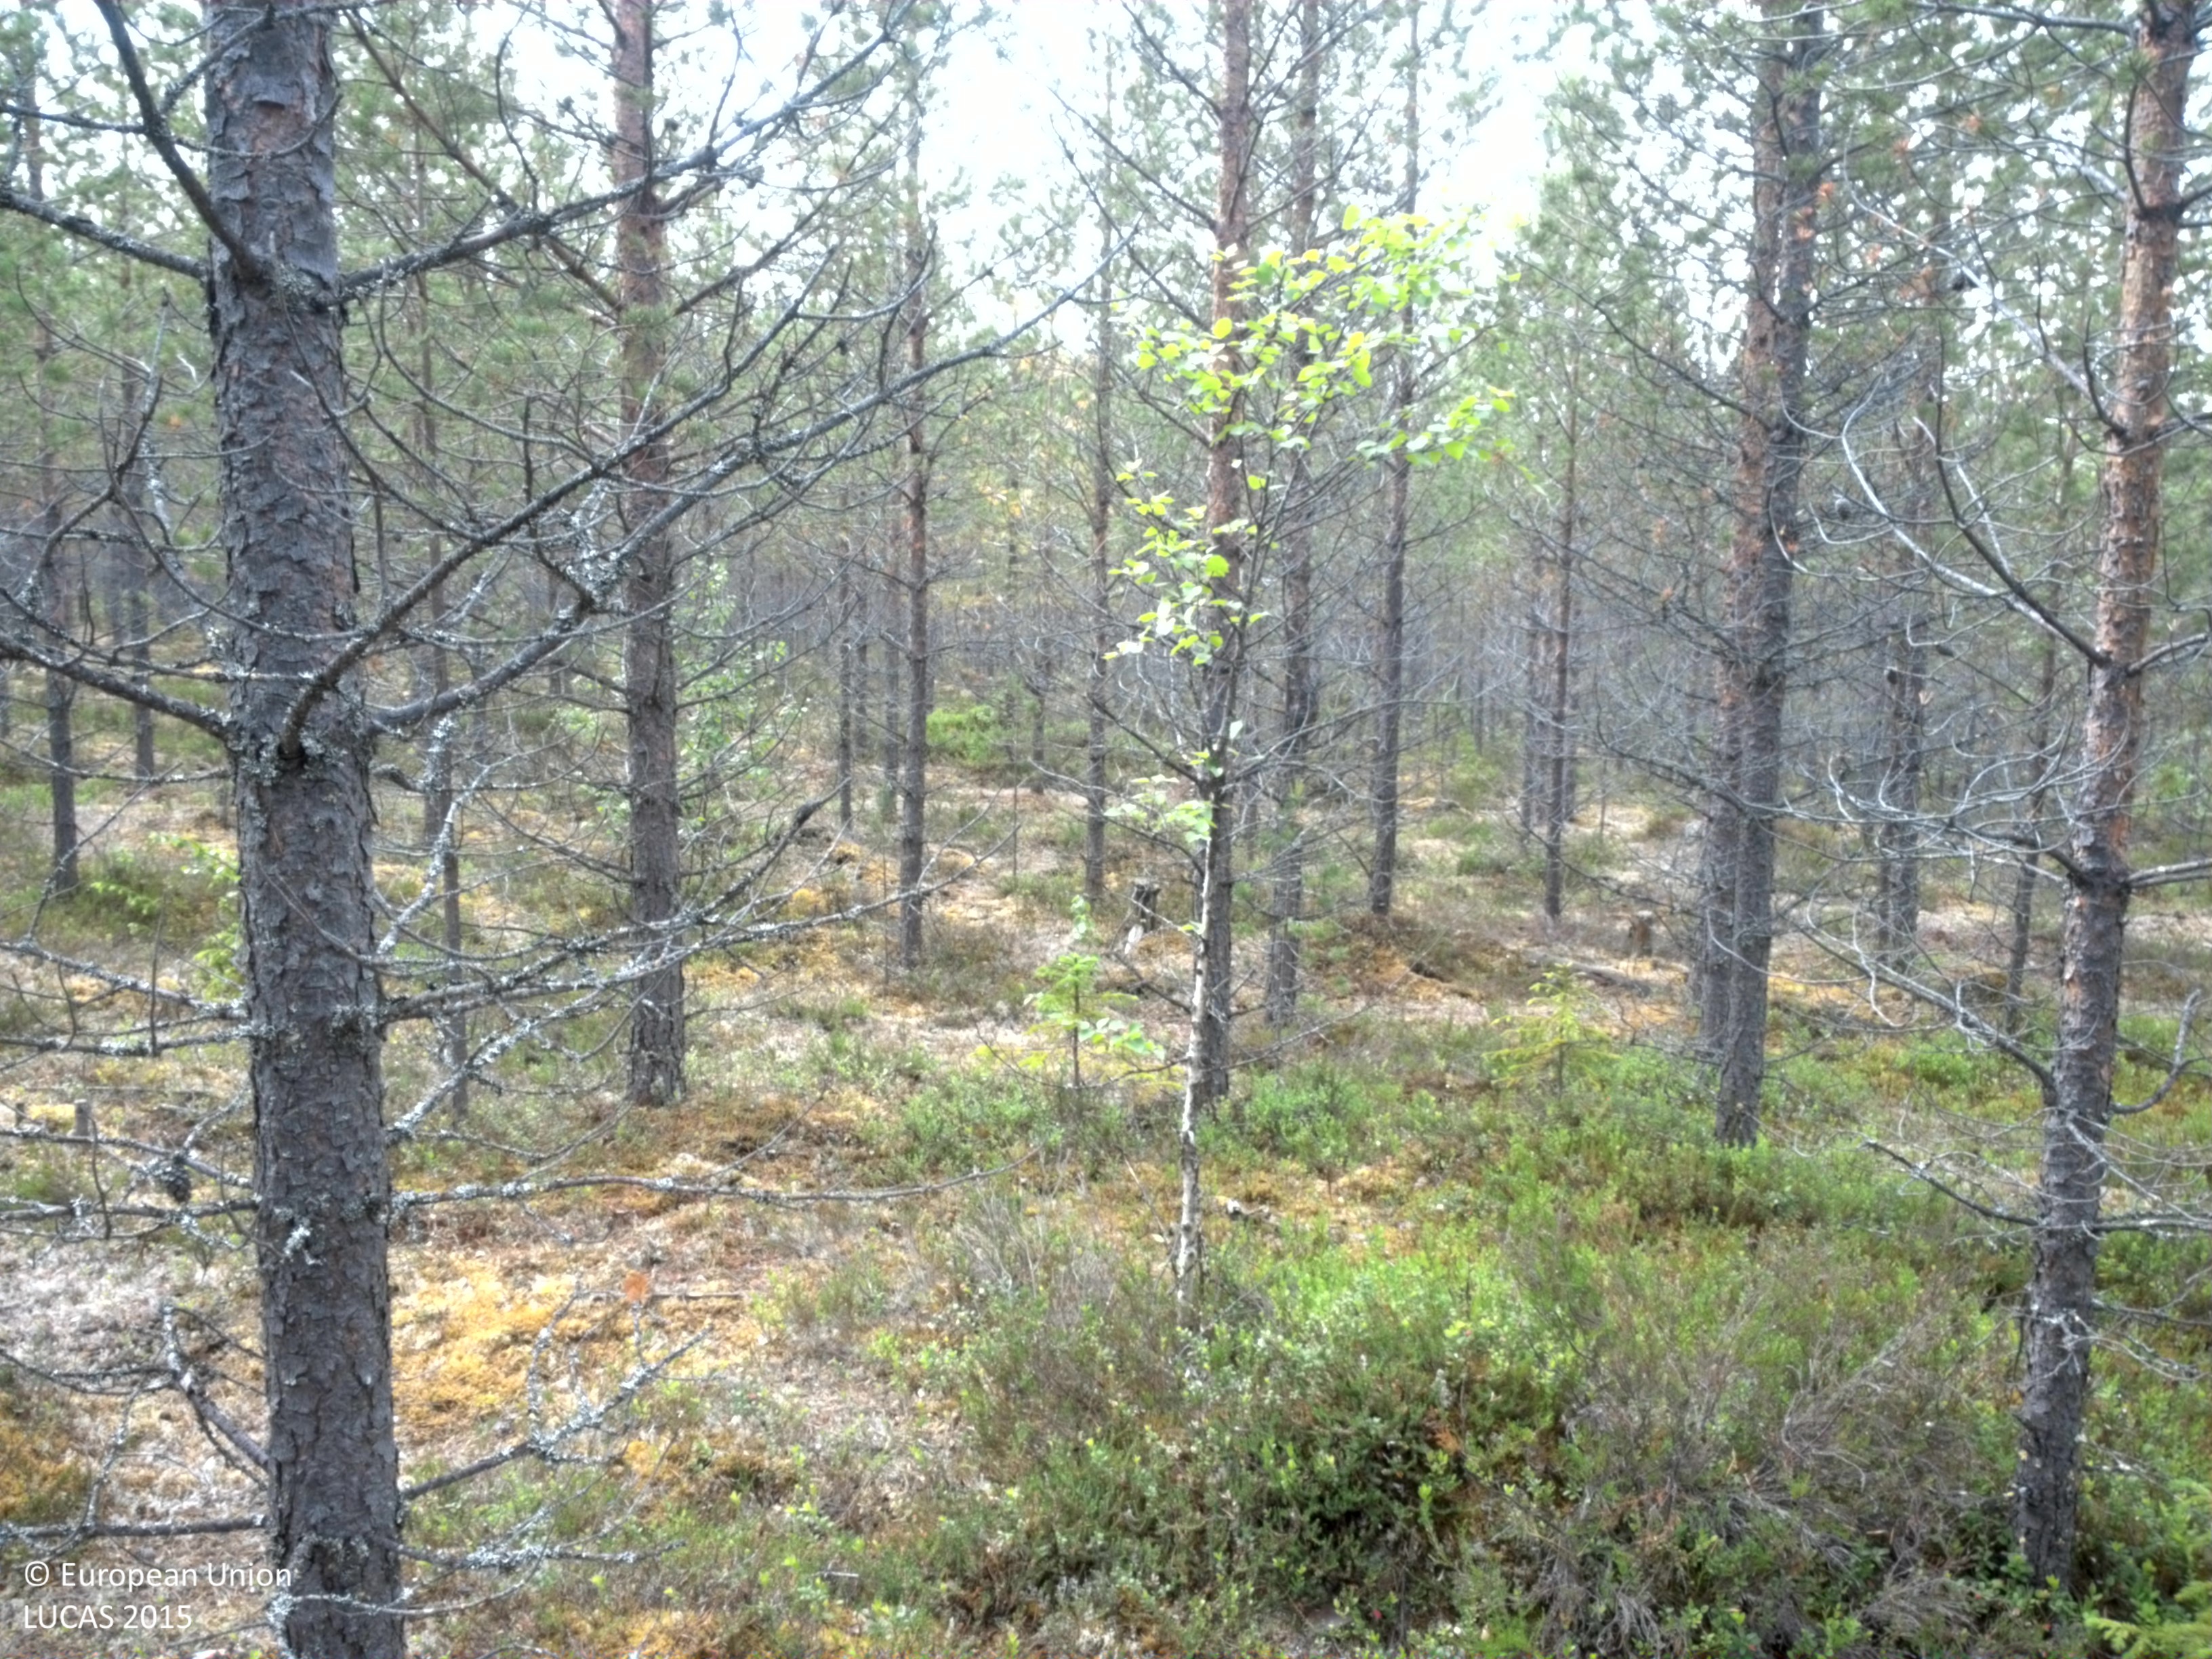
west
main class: Woodland
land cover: Pine dominated coniferous woodland
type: boreal forest
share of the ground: 50 - 75 %
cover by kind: coniferous forest trees 75 %, shrubs 15 %, lichens and mosses 10 %
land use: Forestry
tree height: > 5 m
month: July
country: SE
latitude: 64.7239
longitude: 18.3414
